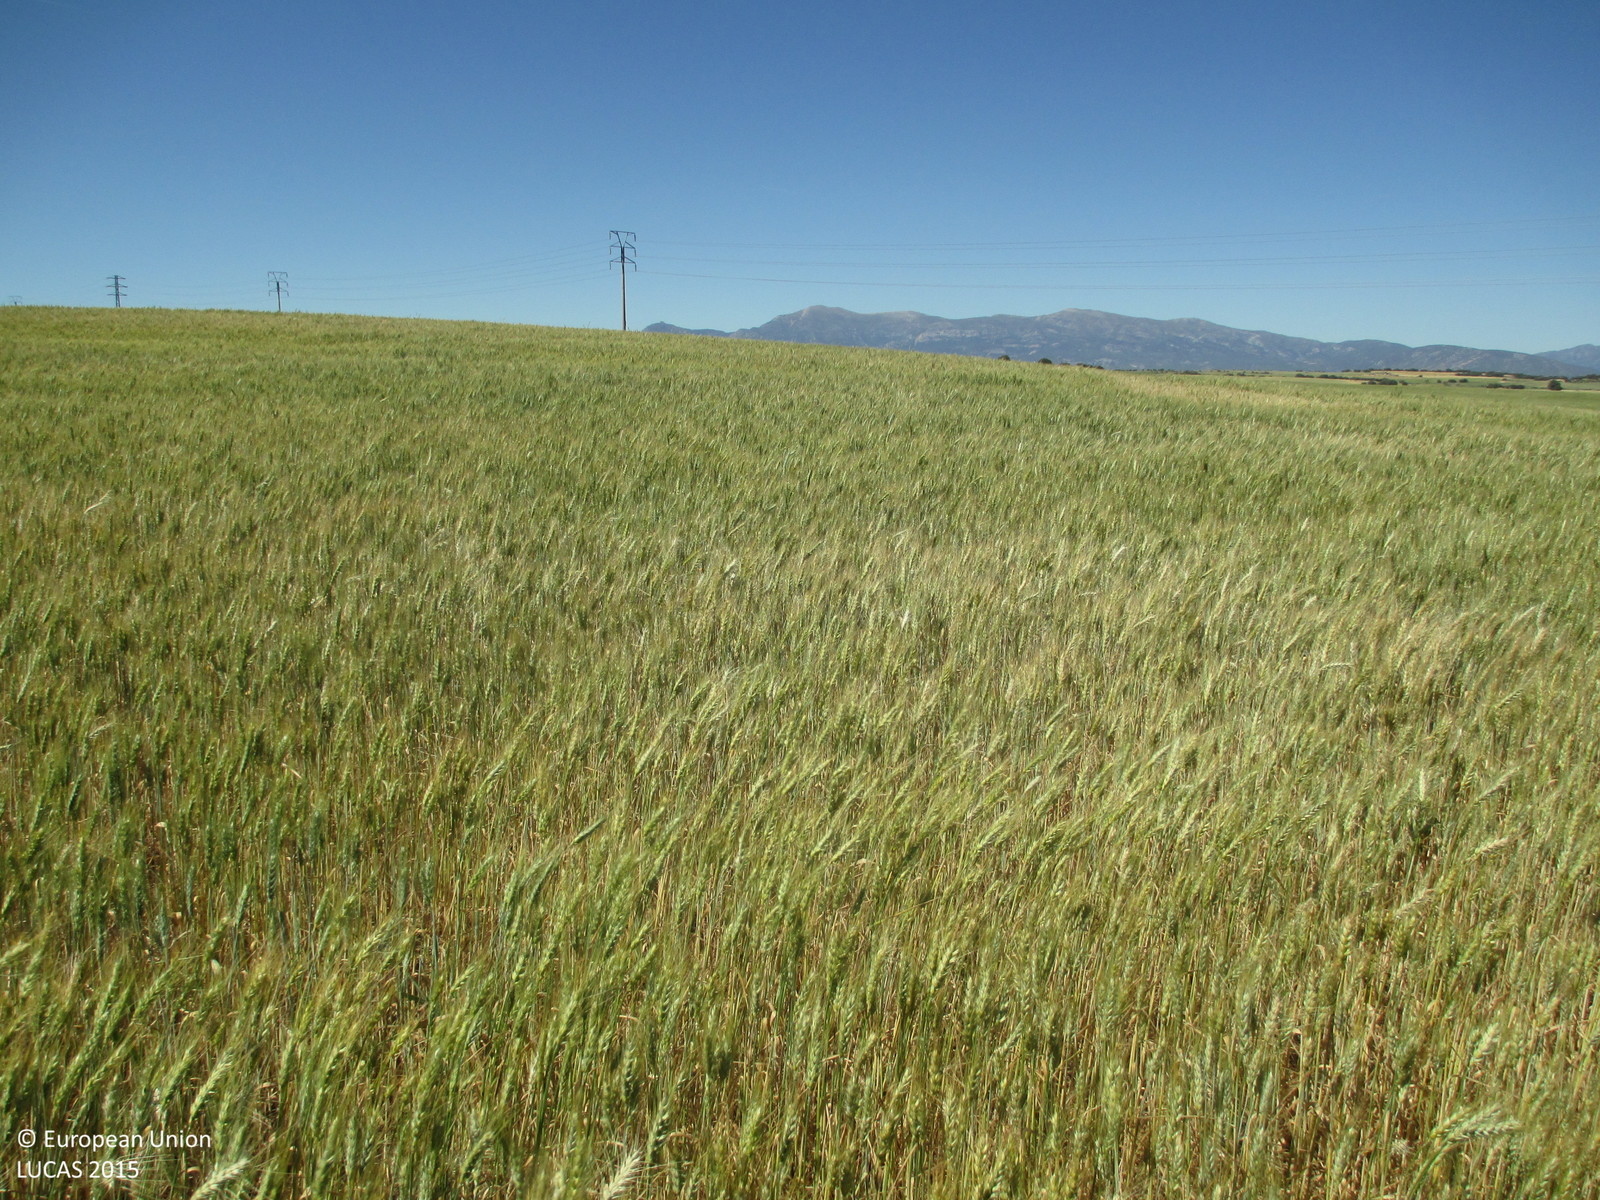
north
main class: Cropland
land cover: Durum wheat
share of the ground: > 75 %
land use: Agriculture (excluding fallow land and kitchen gardens)
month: May
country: ES
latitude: 42.0618
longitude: -0.2321
